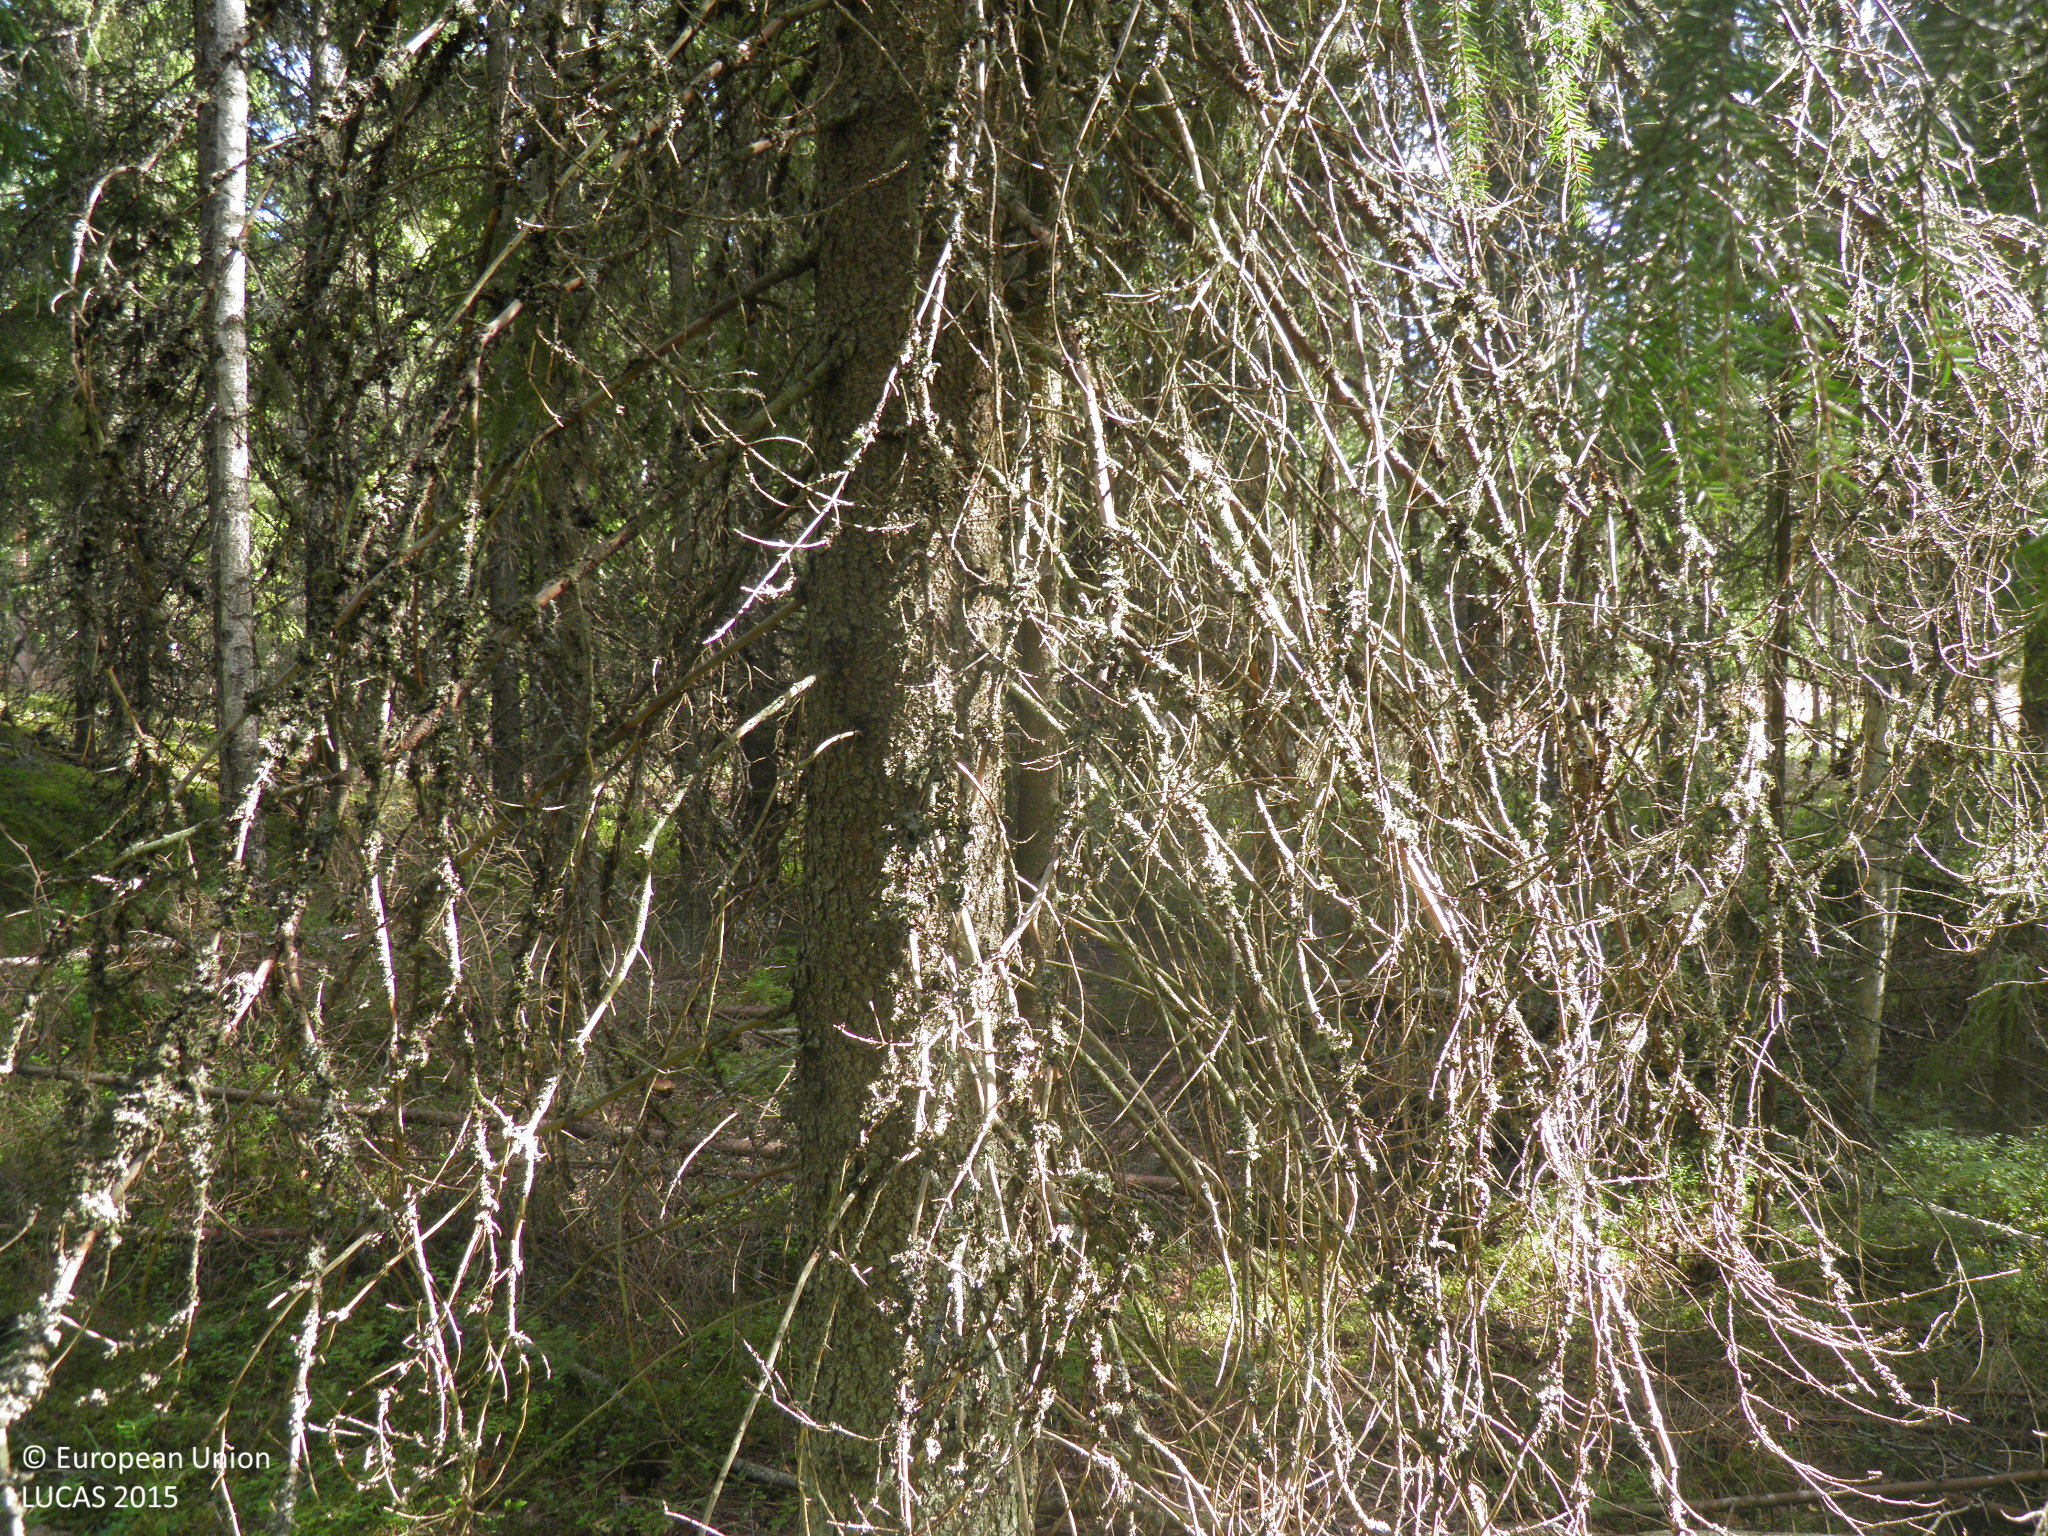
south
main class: Woodland
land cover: Spruce dominated coniferous woodland
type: hemiboreal forest and nemoral coniferous forest and mixed broadleaved-coniferous forest
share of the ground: 50 - 75 %
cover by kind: coniferous forest trees 50 %, shrubs 20 %, lichens and mosses 20 %, broadleaved forest trees 10 %
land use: Forestry
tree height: > 5 m
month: August
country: FI
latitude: 61.1326
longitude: 22.5634
